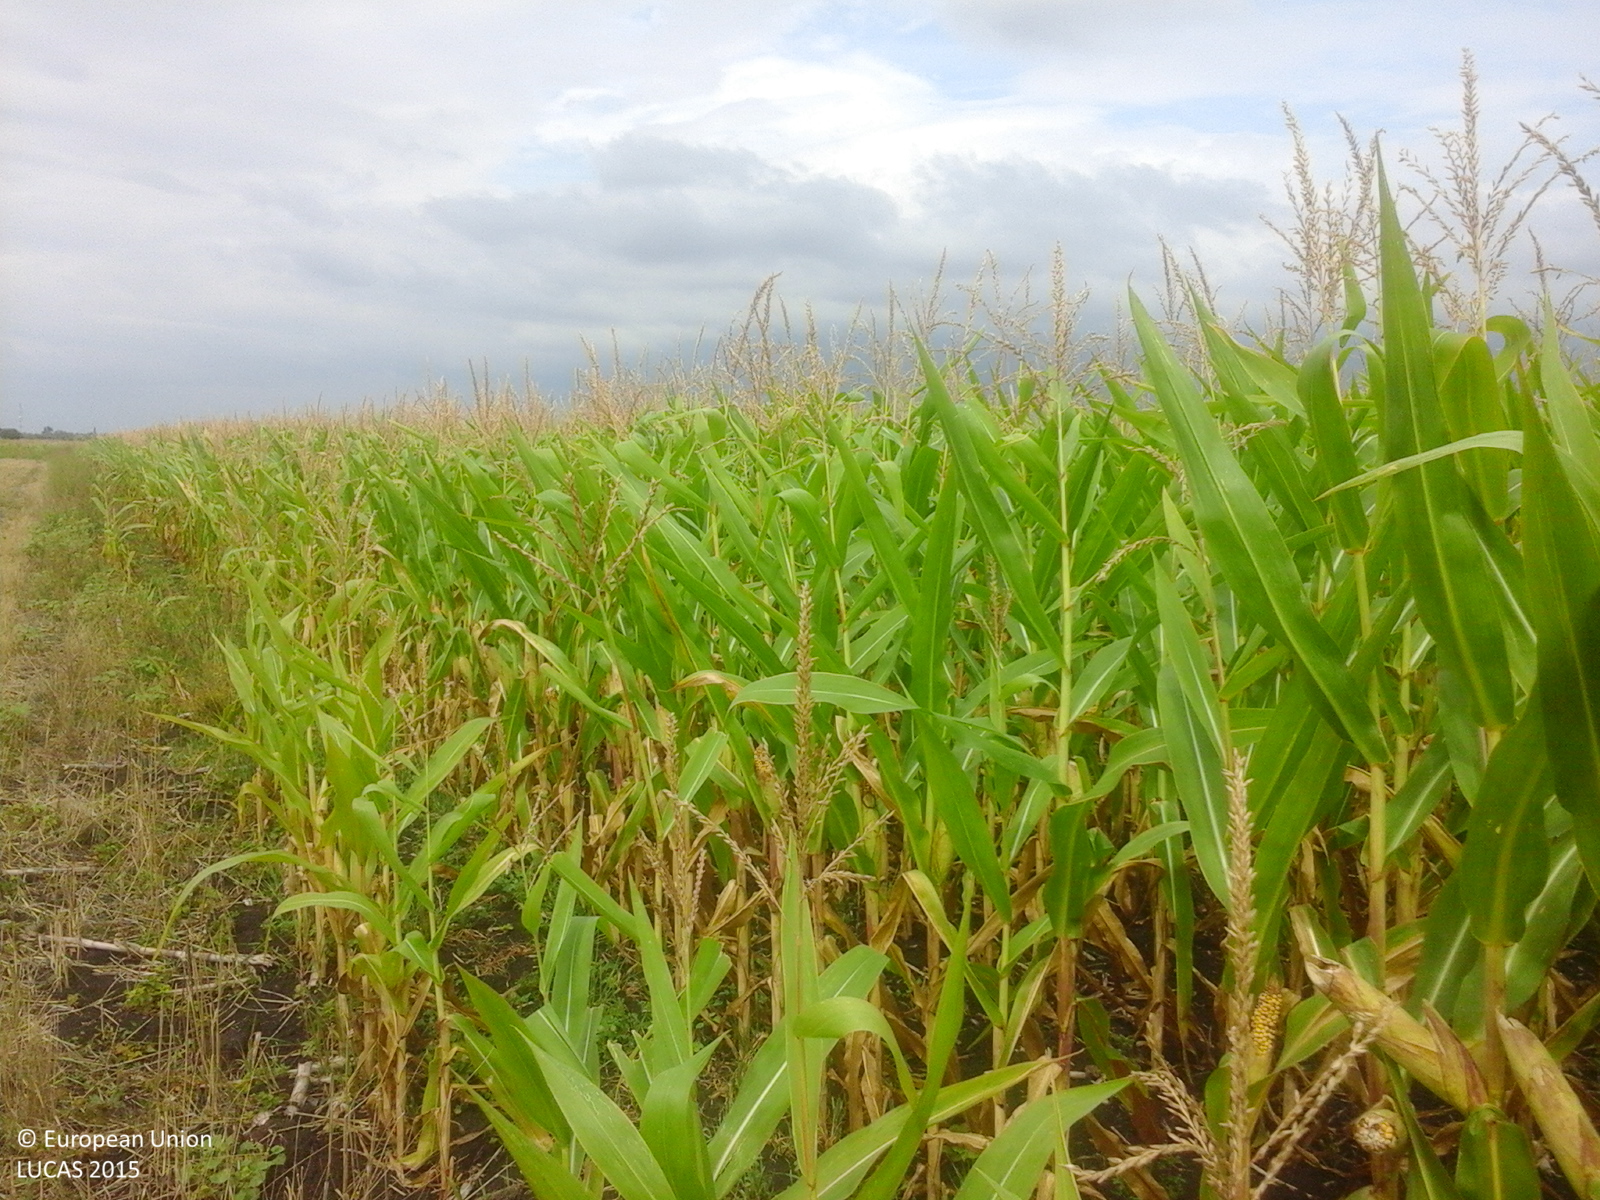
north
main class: Cropland
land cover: Maize
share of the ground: > 75 %
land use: Agriculture (excluding fallow land and kitchen gardens)
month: August
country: RO
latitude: 45.4776
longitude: 21.3001
